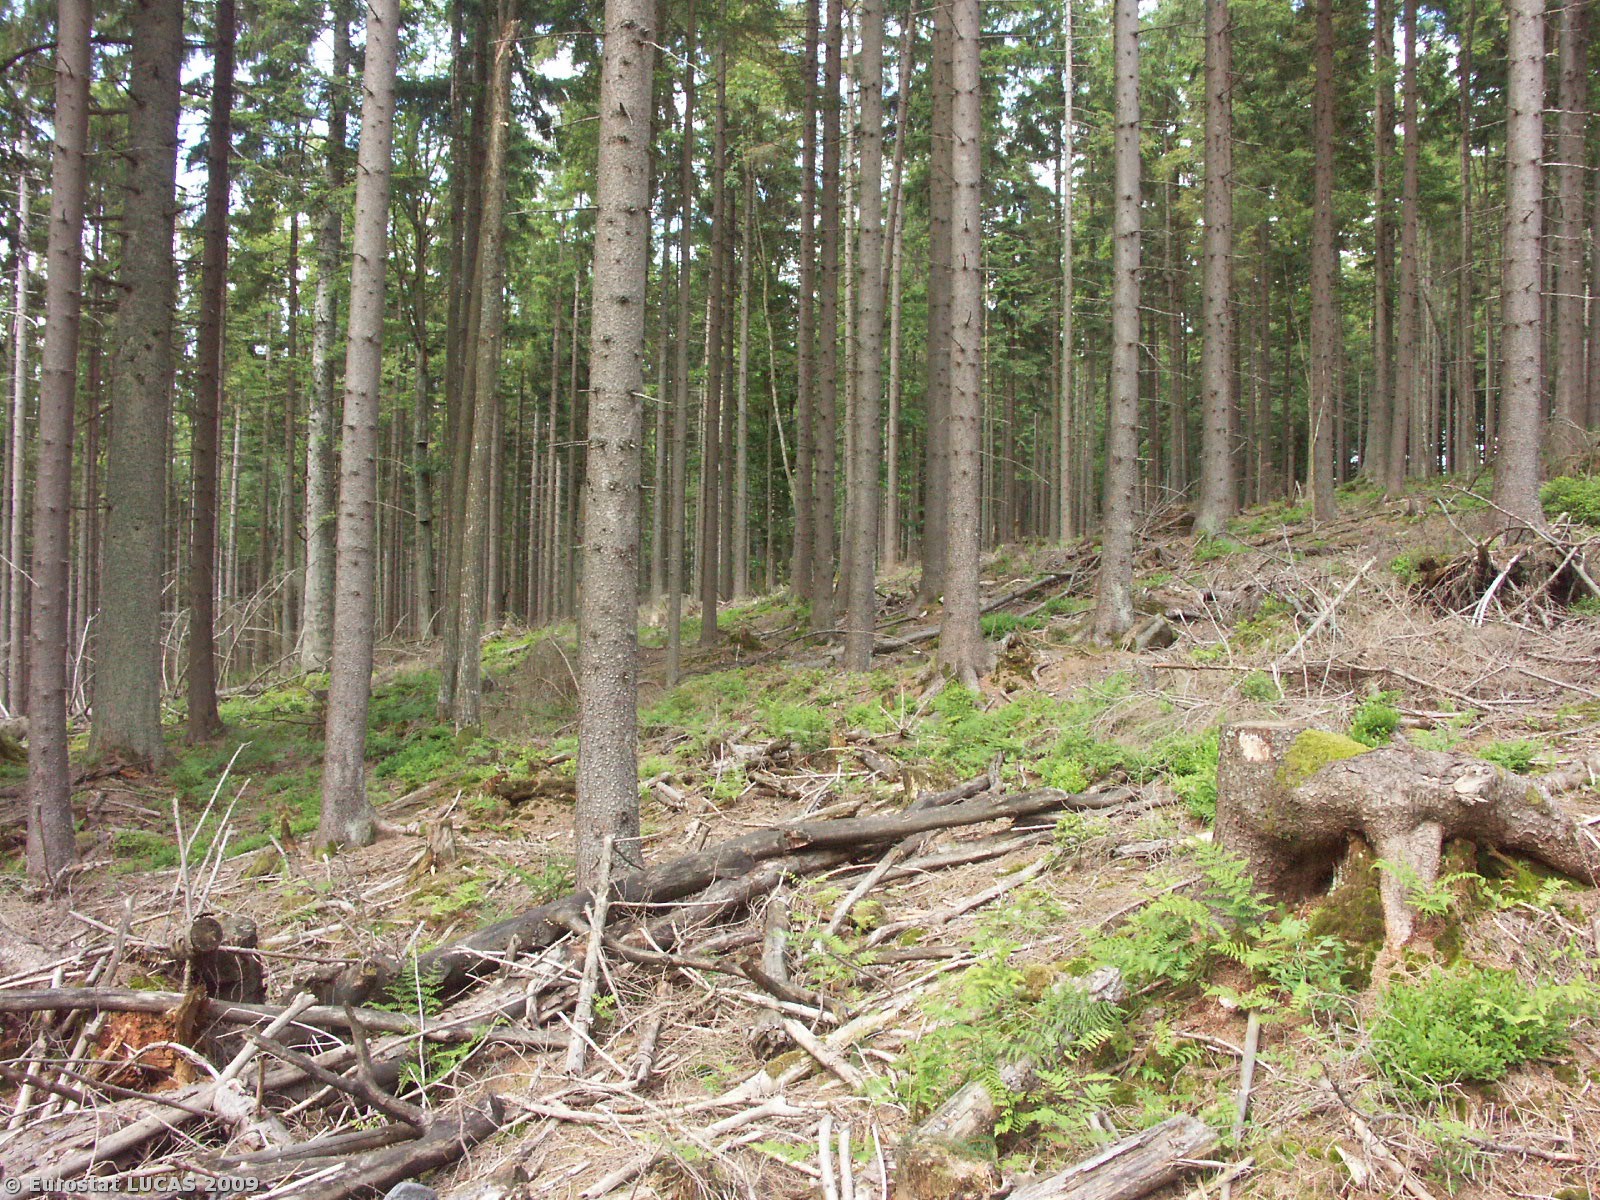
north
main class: Woodland
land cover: Coniferous woodland
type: hemiboreal forest and nemoral coniferous forest and mixed broadleaved-coniferous forest
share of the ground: > 75 %
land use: Forestry
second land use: Nature reserves
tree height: > 5 m
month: June
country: CZ
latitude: 48.6523
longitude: 14.0862
